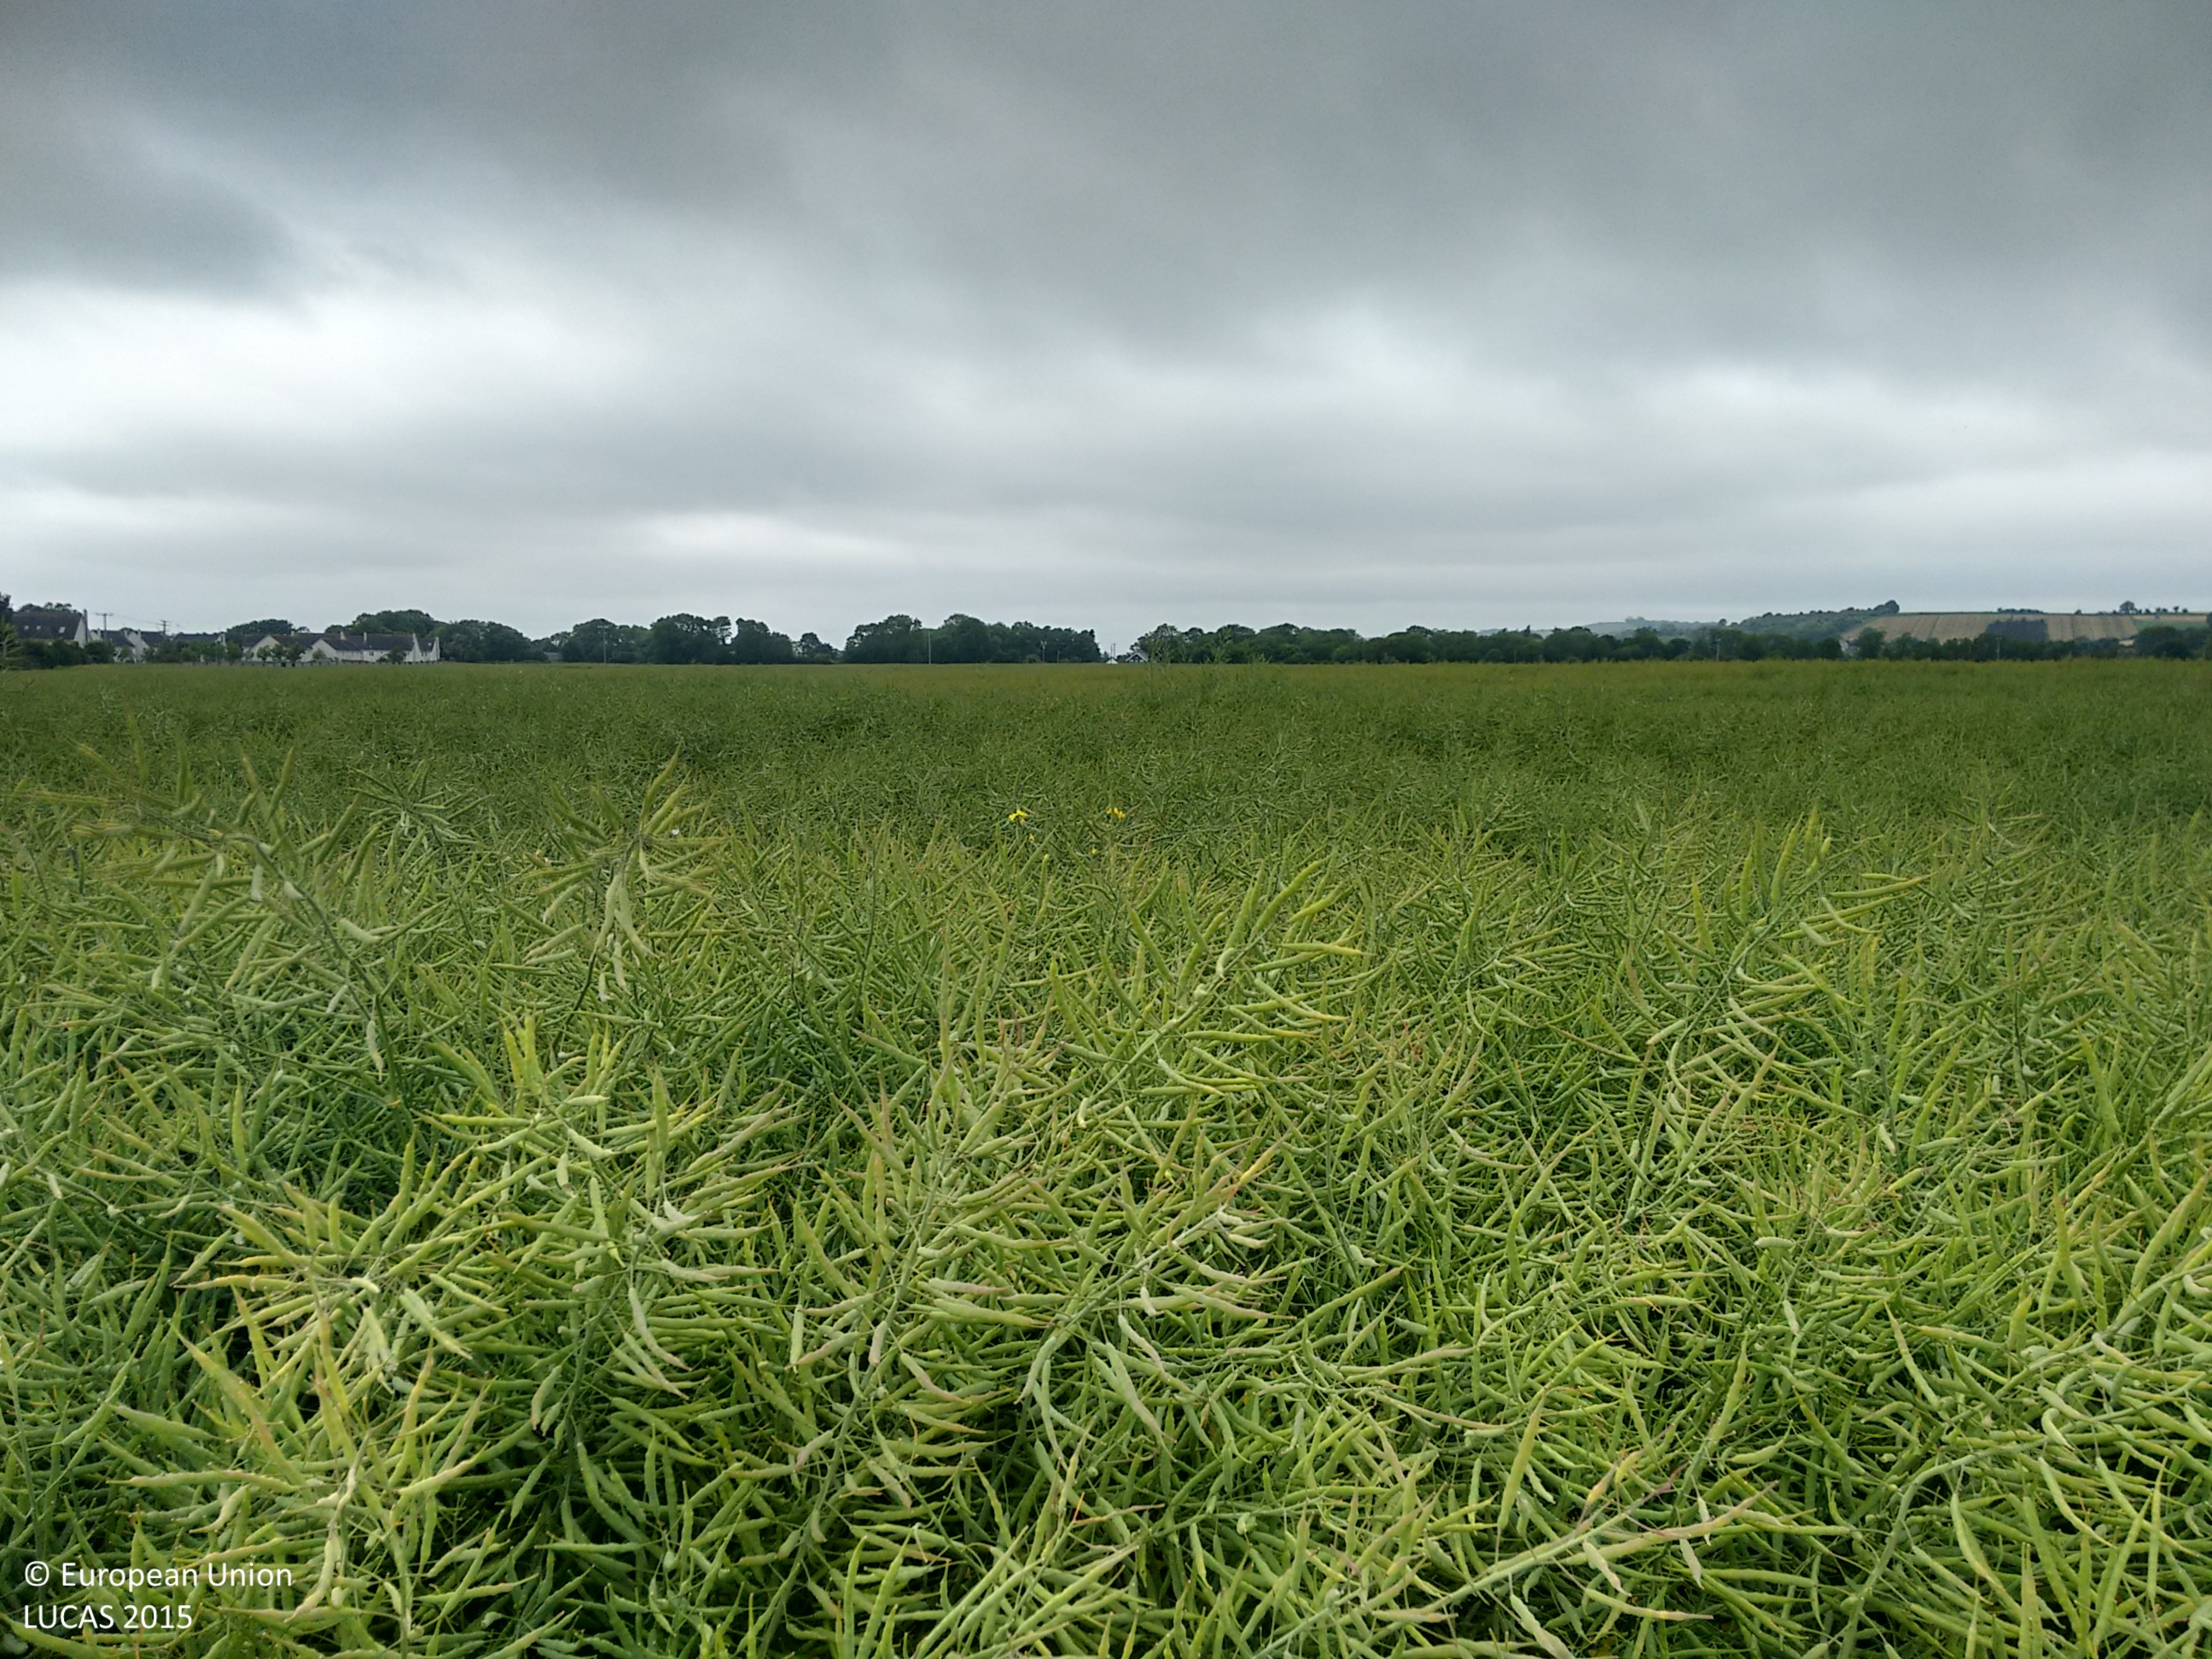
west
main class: Cropland
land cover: Rape and turnip rape
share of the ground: > 75 %
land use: Agriculture (excluding fallow land and kitchen gardens)
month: June
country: IE
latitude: 51.9355
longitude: -8.0536
